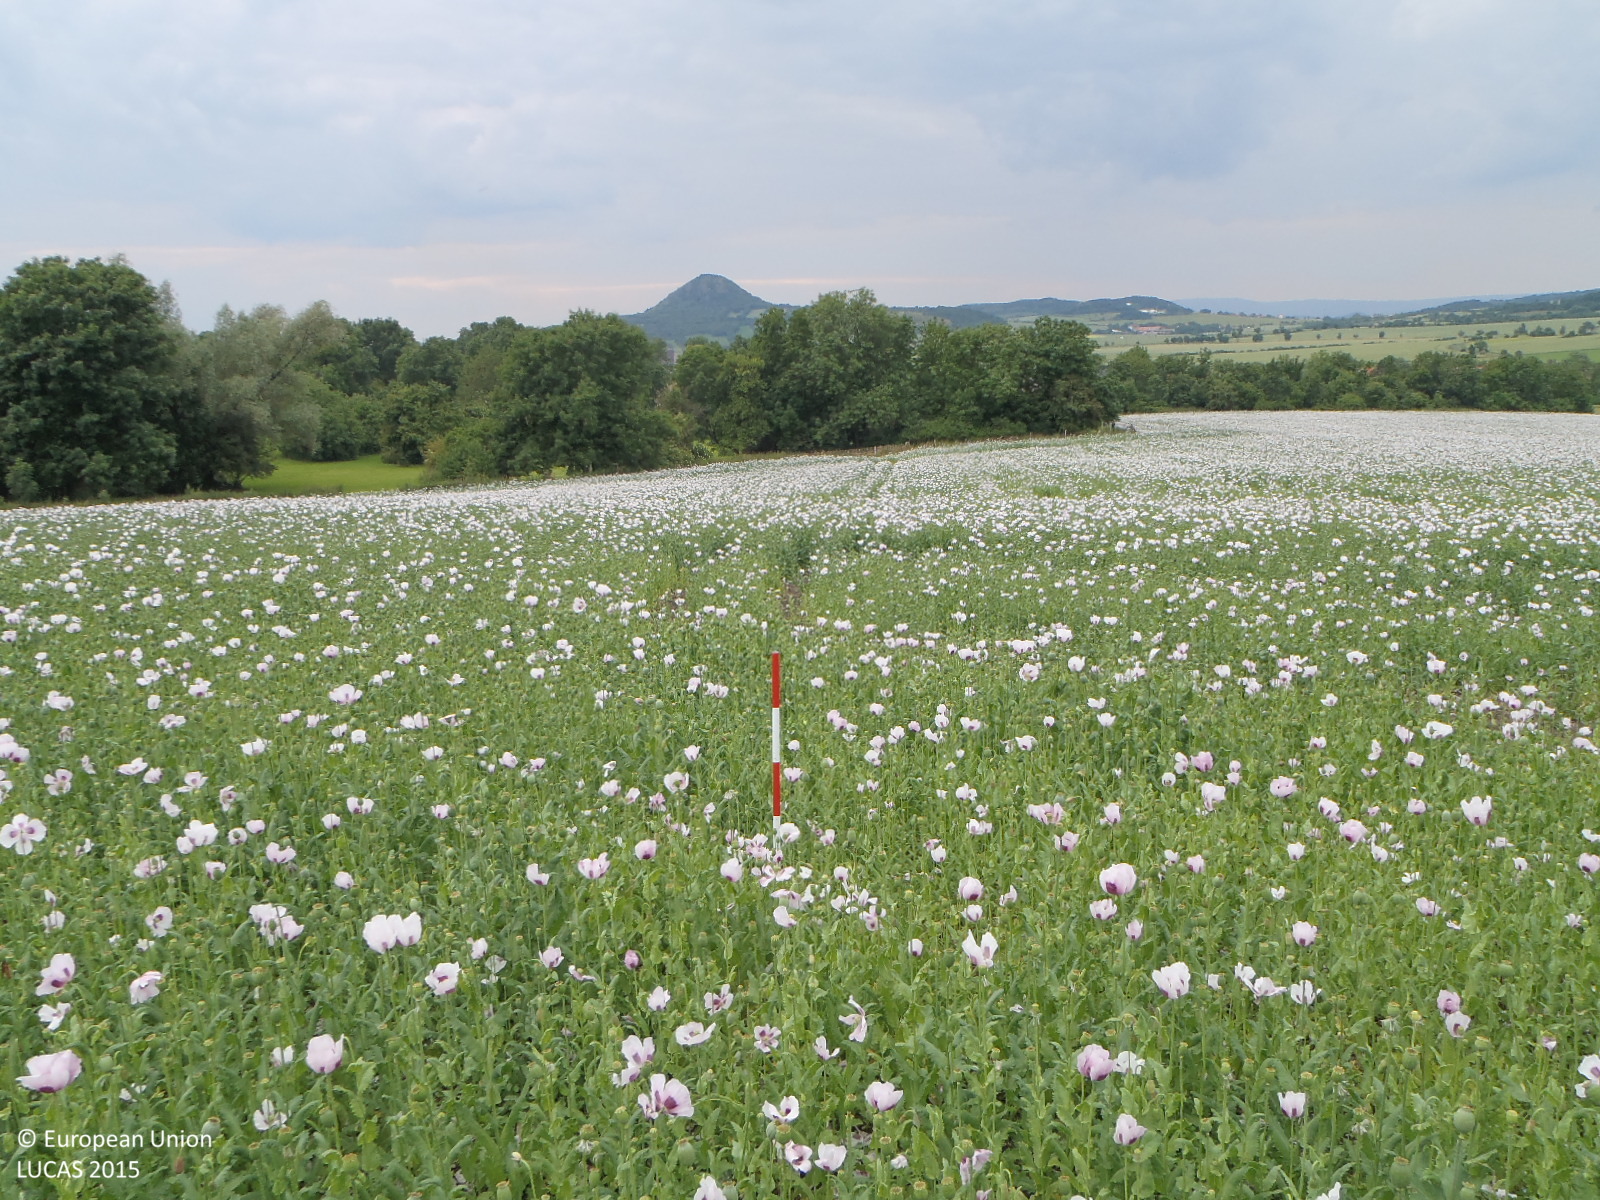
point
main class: Cropland
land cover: Other fibre and oleaginous crops
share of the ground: > 75 %
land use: Agriculture (excluding fallow land and kitchen gardens)
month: June
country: CZ
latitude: 50.4265
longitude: 13.8154
